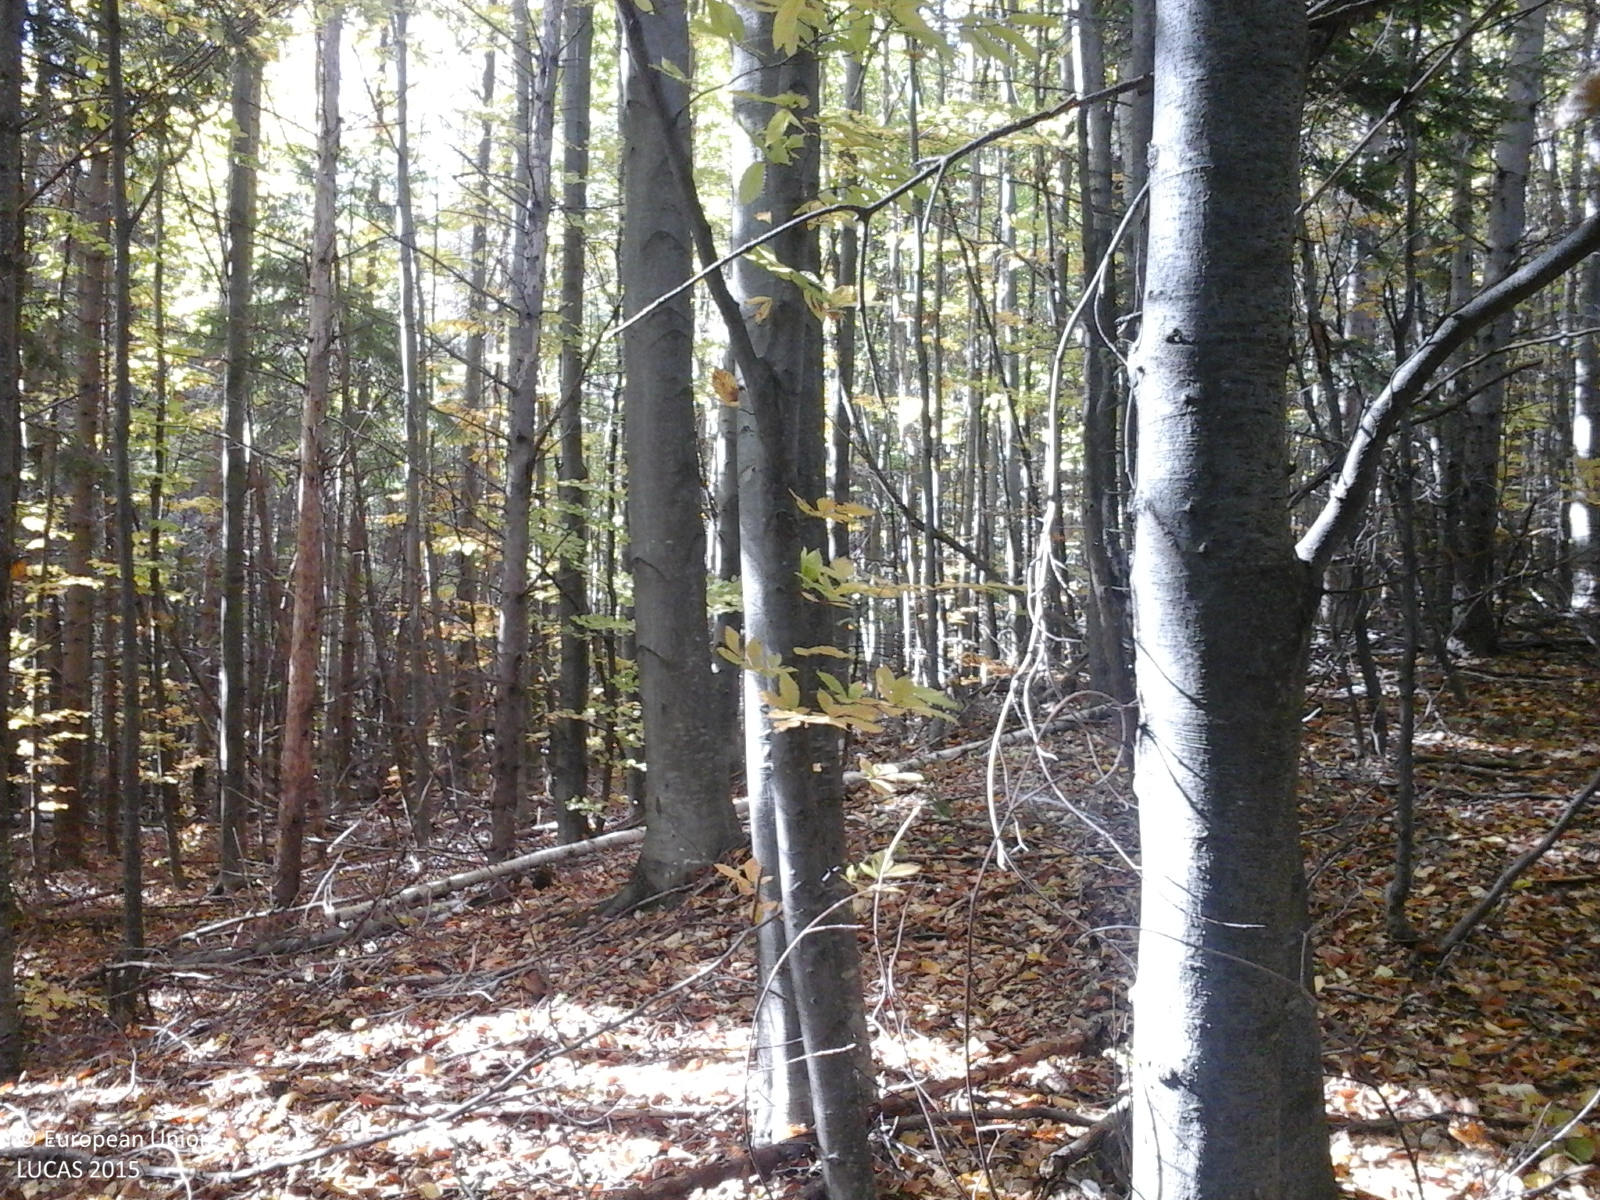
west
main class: Woodland
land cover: Broadleaved woodland
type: beech forest
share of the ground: > 75 %
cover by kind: broadleaved forest trees 100 %
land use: Forestry
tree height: > 5 m
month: October
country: RO
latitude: 46.0471
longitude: 26.6372
